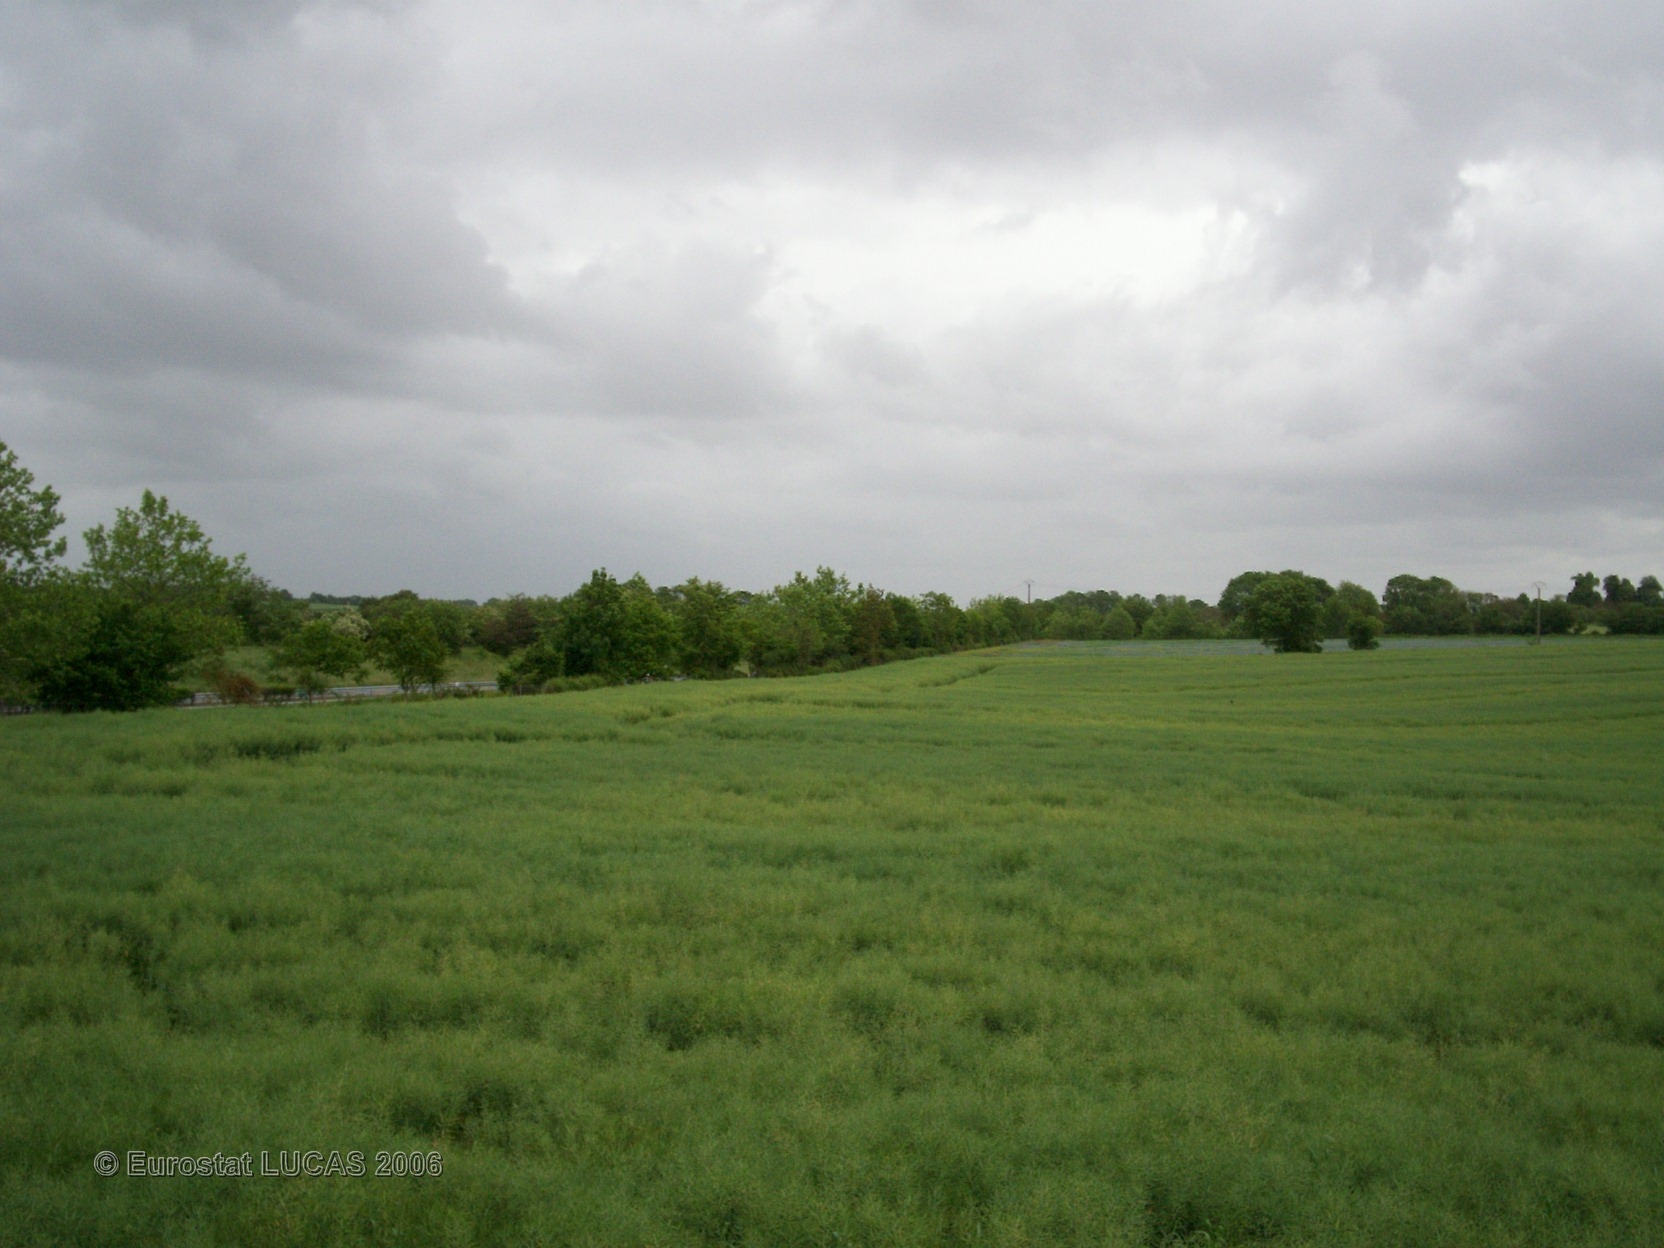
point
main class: Cropland
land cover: Rape and turnip rape
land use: Agriculture (excluding fallow land and kitchen gardens)
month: May
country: FR
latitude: 46.3679
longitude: -0.2273
